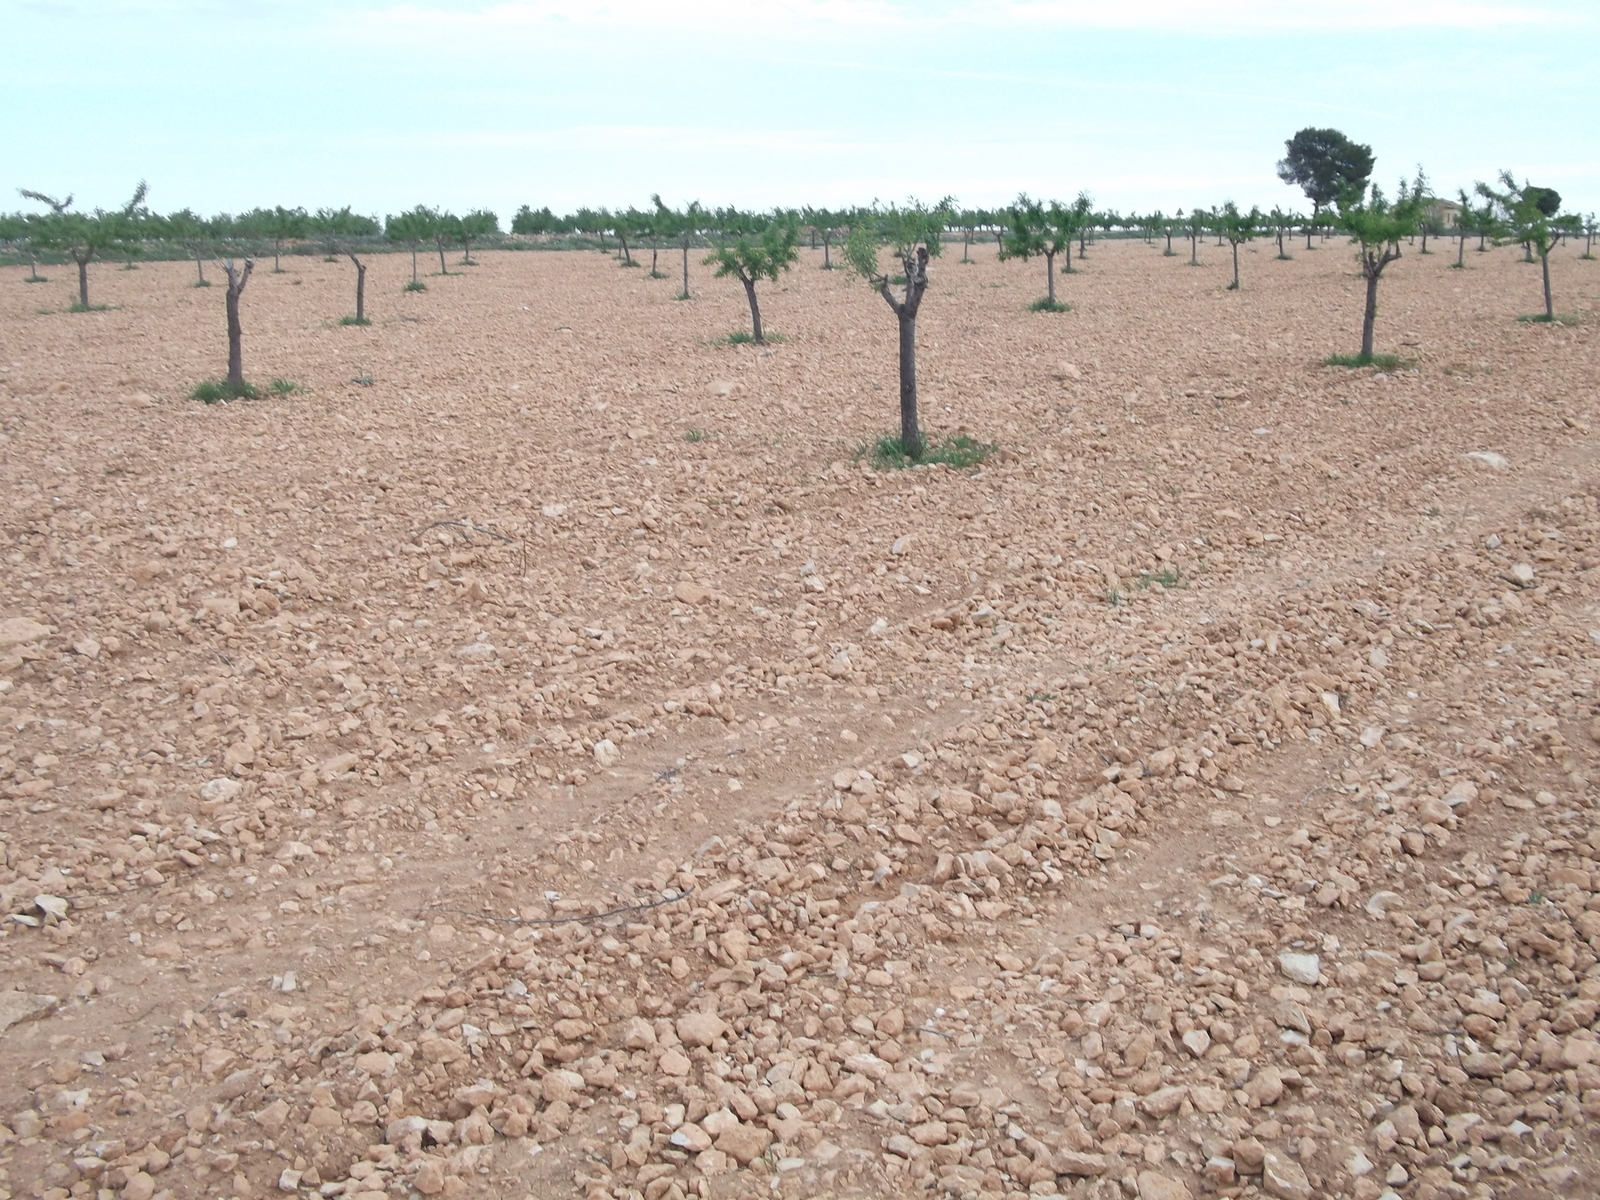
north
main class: Cropland
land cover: Nuts trees
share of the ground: < 10 %
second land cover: Other bare soil
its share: > 75 %
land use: Agriculture (excluding fallow land and kitchen gardens)
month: April
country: ES
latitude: 38.1038
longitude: -1.5397
